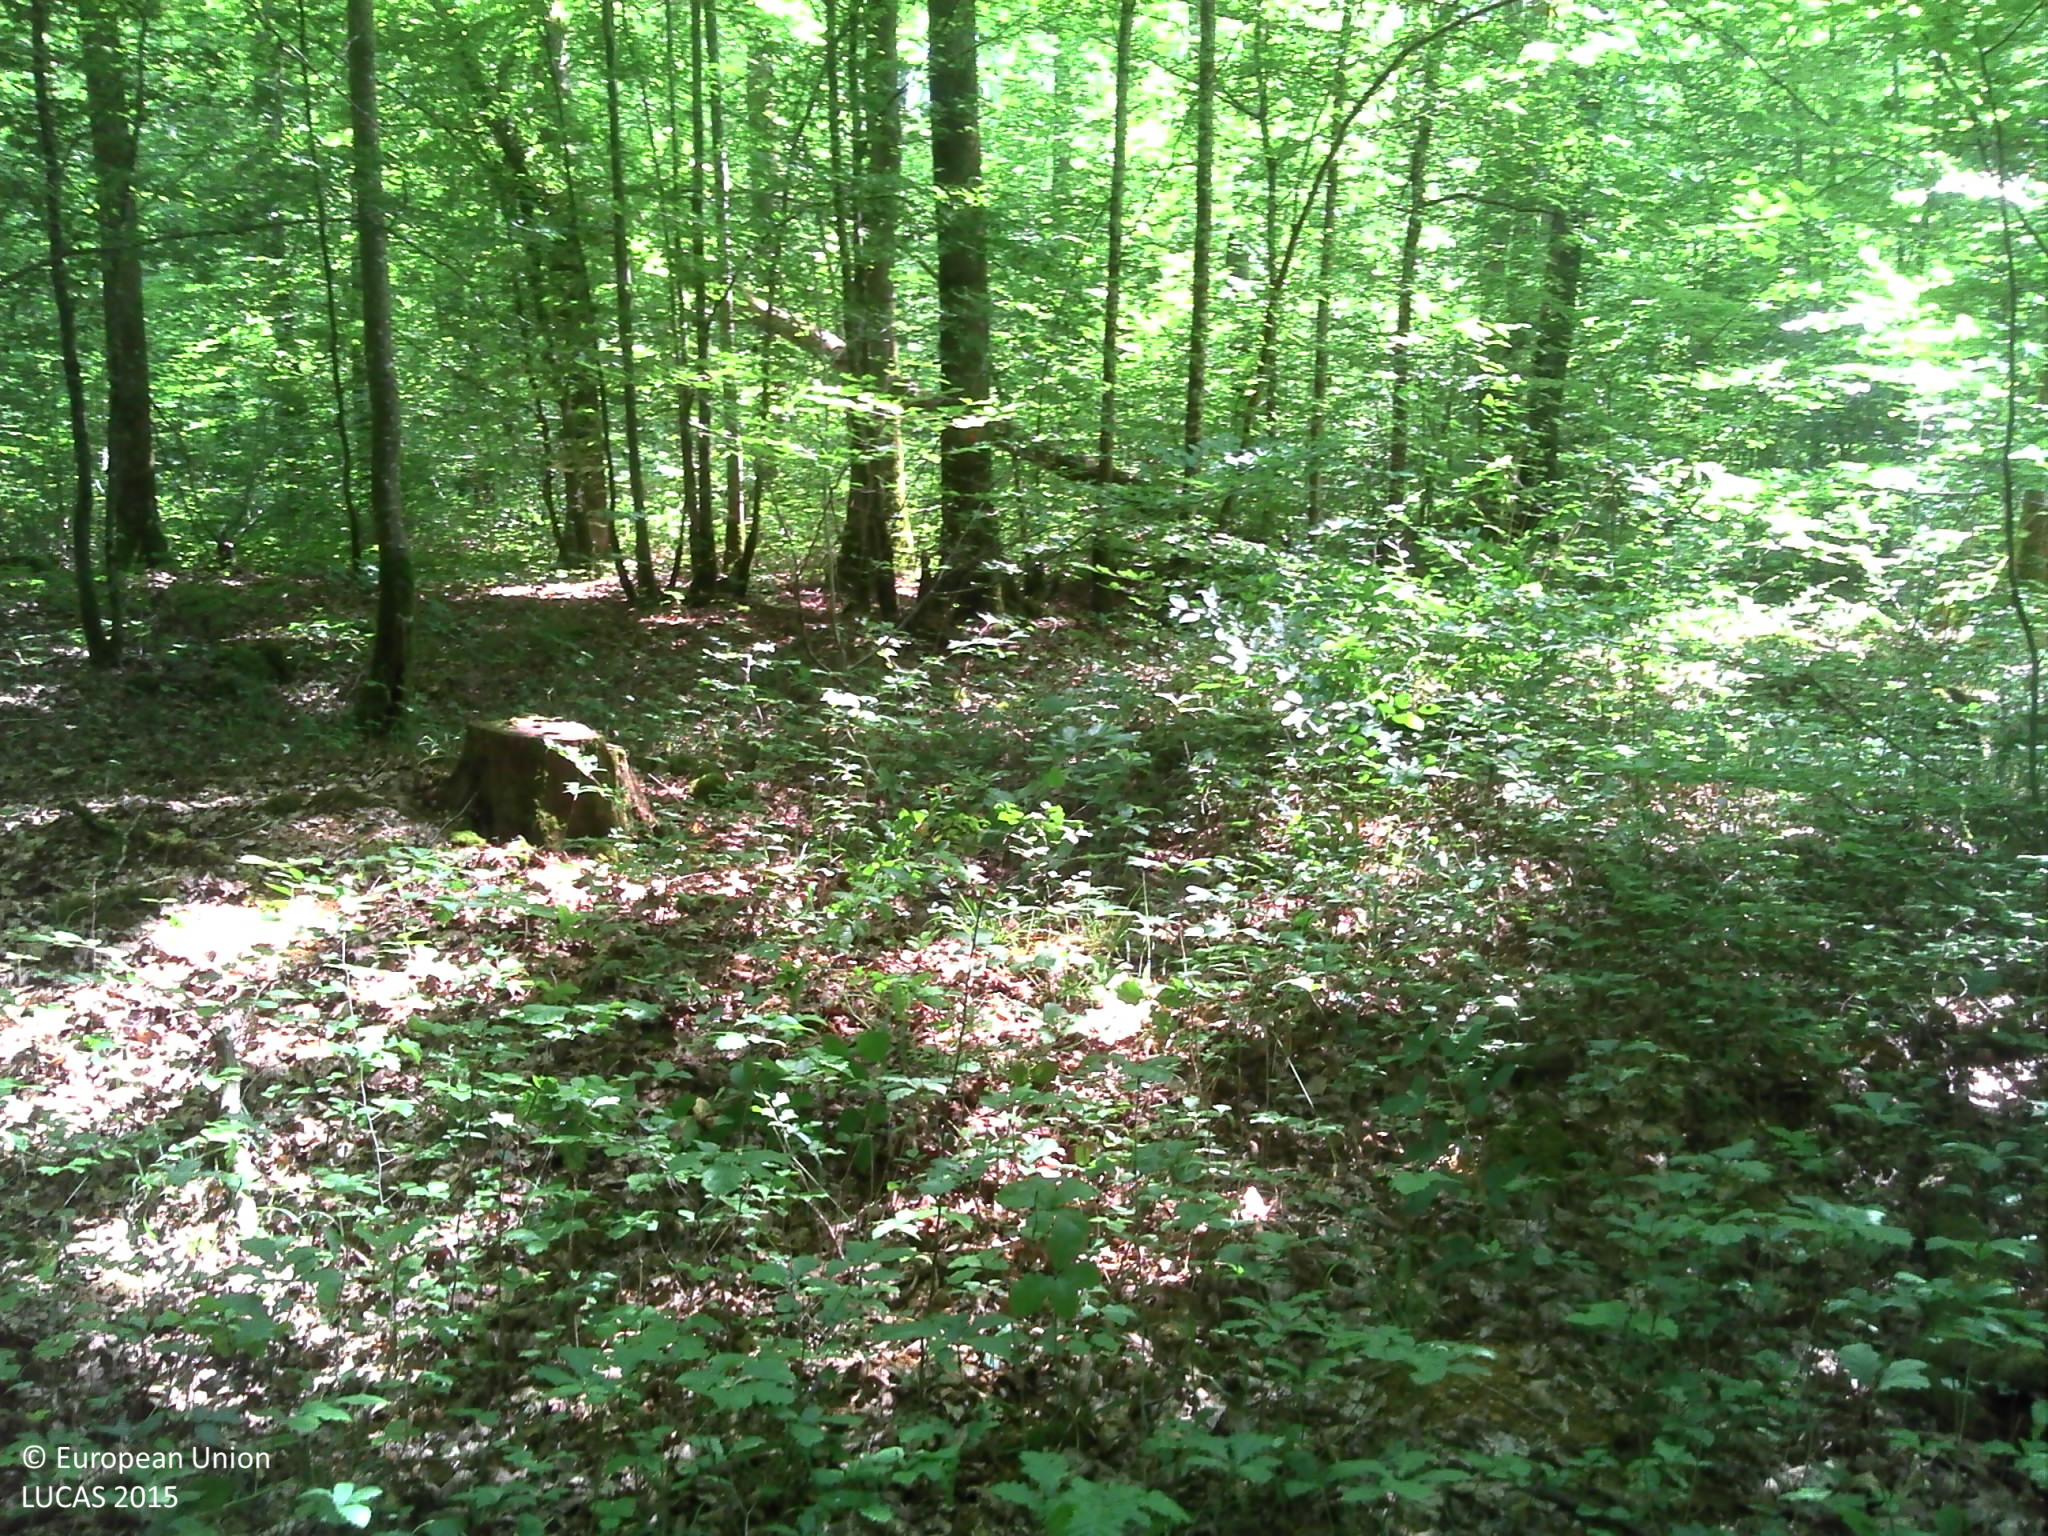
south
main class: Woodland
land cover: Broadleaved woodland
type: mesophytic deciduous forest
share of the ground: > 75 %
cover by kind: broadleaved forest trees 90 %, herbaceous plants 5 %, lichens and mosses 5 %
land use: Forestry
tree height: > 5 m
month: June
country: FR
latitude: 47.4772
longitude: 3.5874
